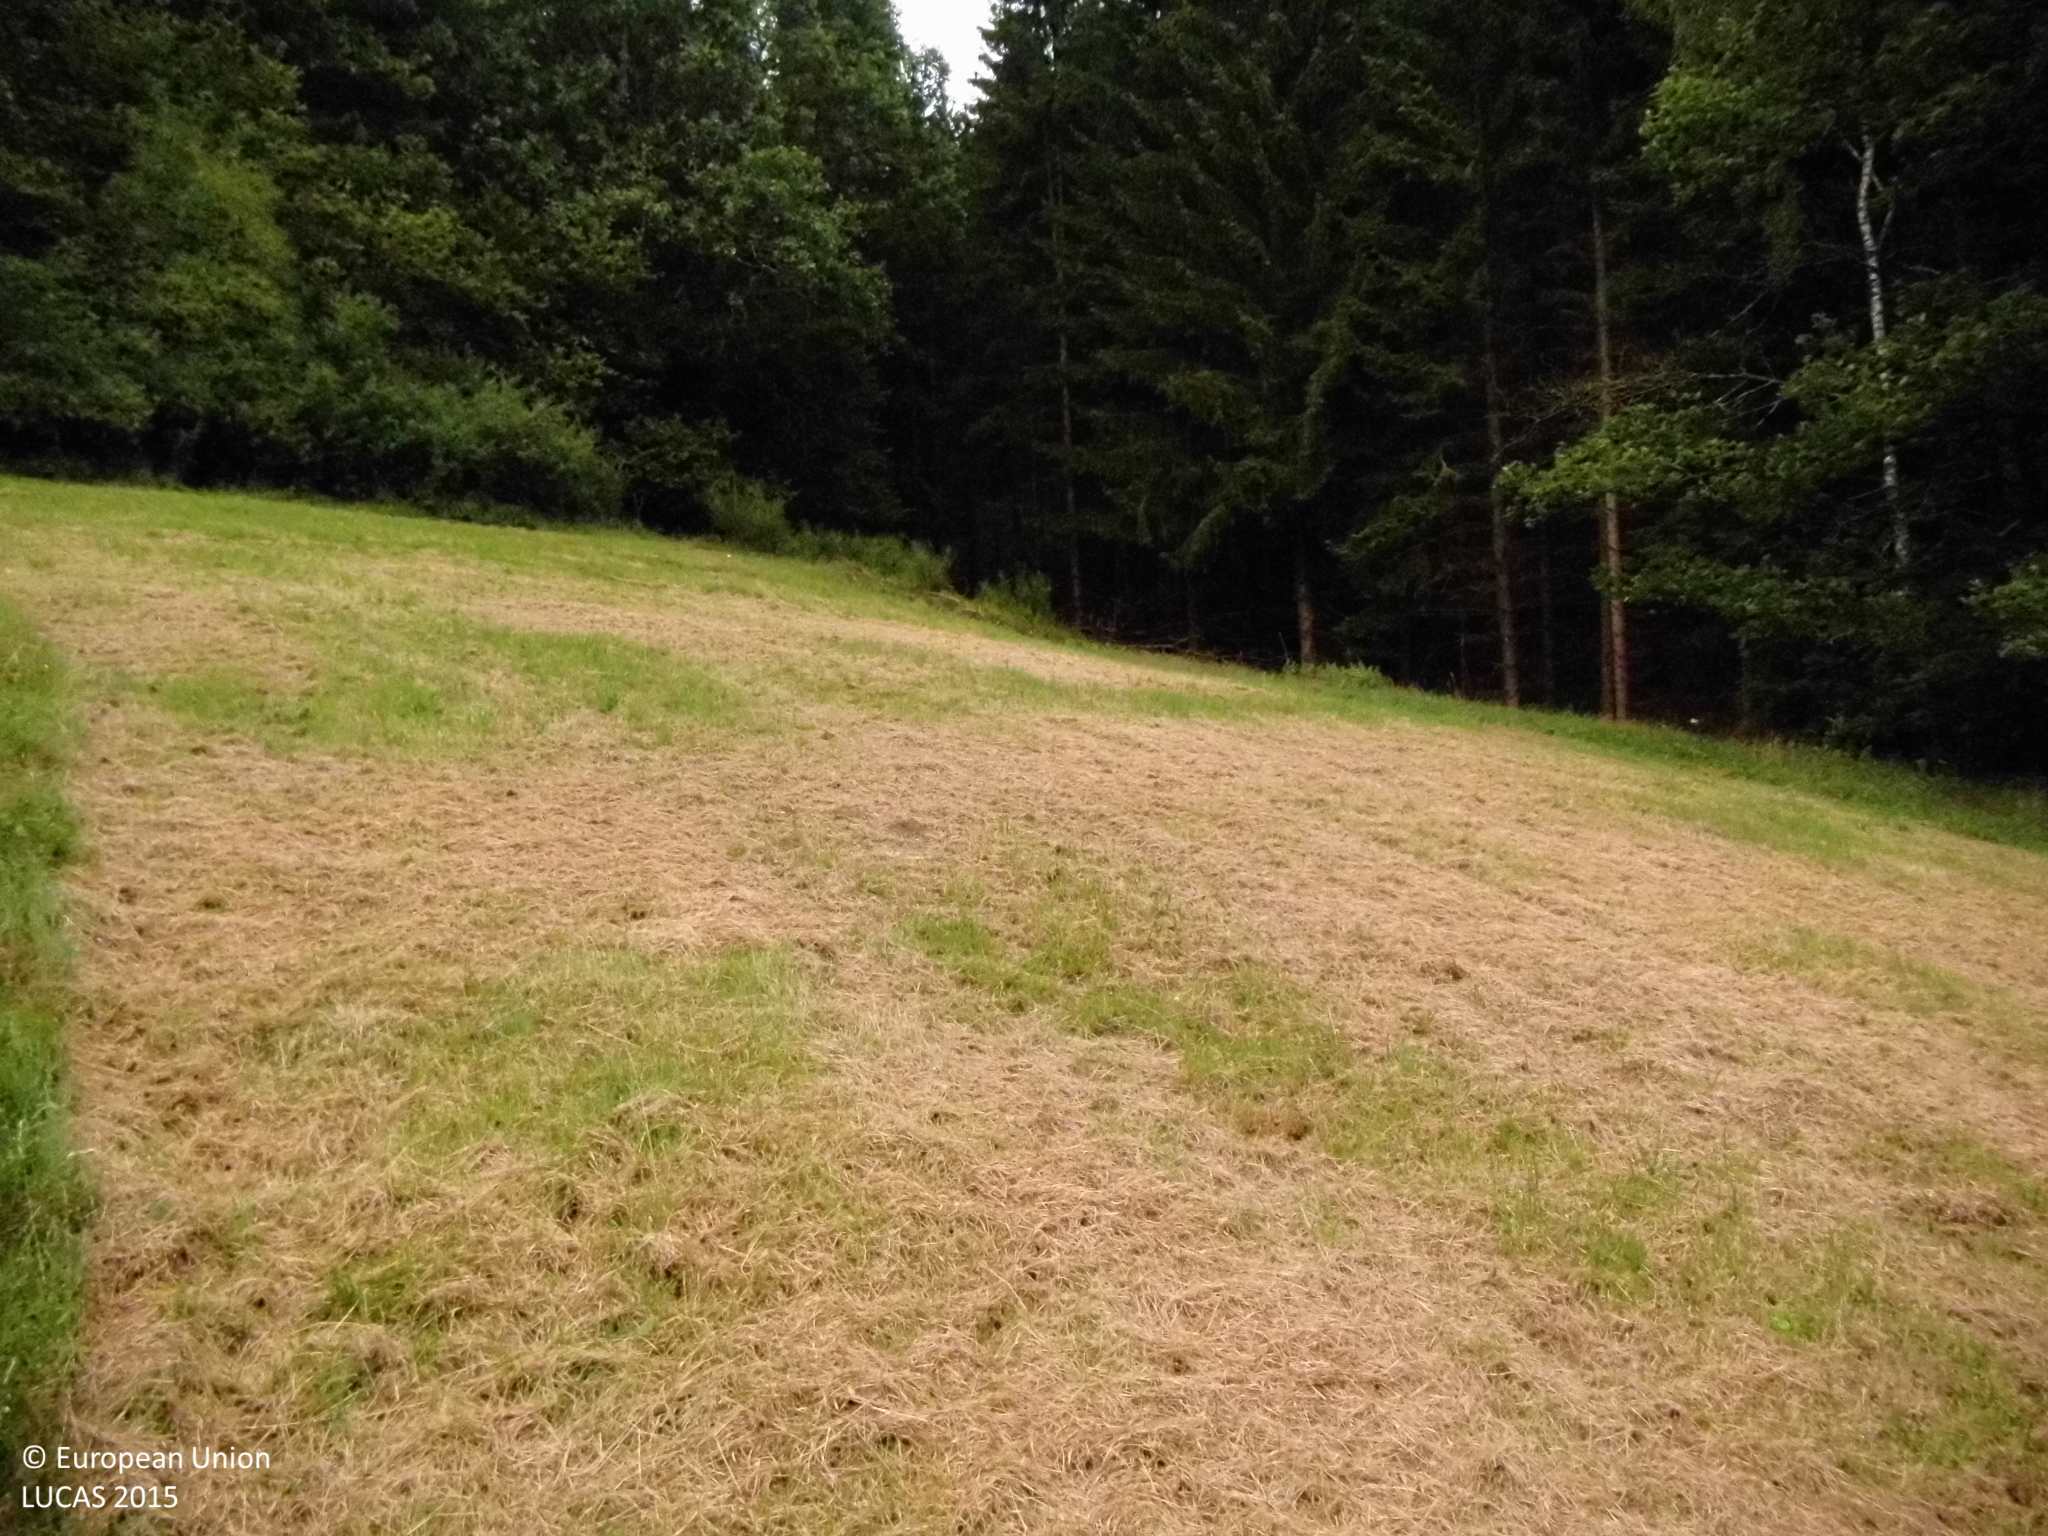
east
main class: Grassland
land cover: Grassland without tree/shrub cover
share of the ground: > 75 %
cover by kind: herbaceous plants 100 %
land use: Agriculture (excluding fallow land and kitchen gardens)
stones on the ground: 10 - 25 %
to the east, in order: Grassland without tree/shrub cover; Tracks; Spruce dominated coniferous woodland; Rivers and streams; Spruce dominated coniferous woodland; Tracks; Spruce dominated mixed woodland; Spruce dominated coniferous woodland; Tracks; Spruce dominated coniferous woodland
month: August
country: DE
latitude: 51.1465
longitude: 8.5852
